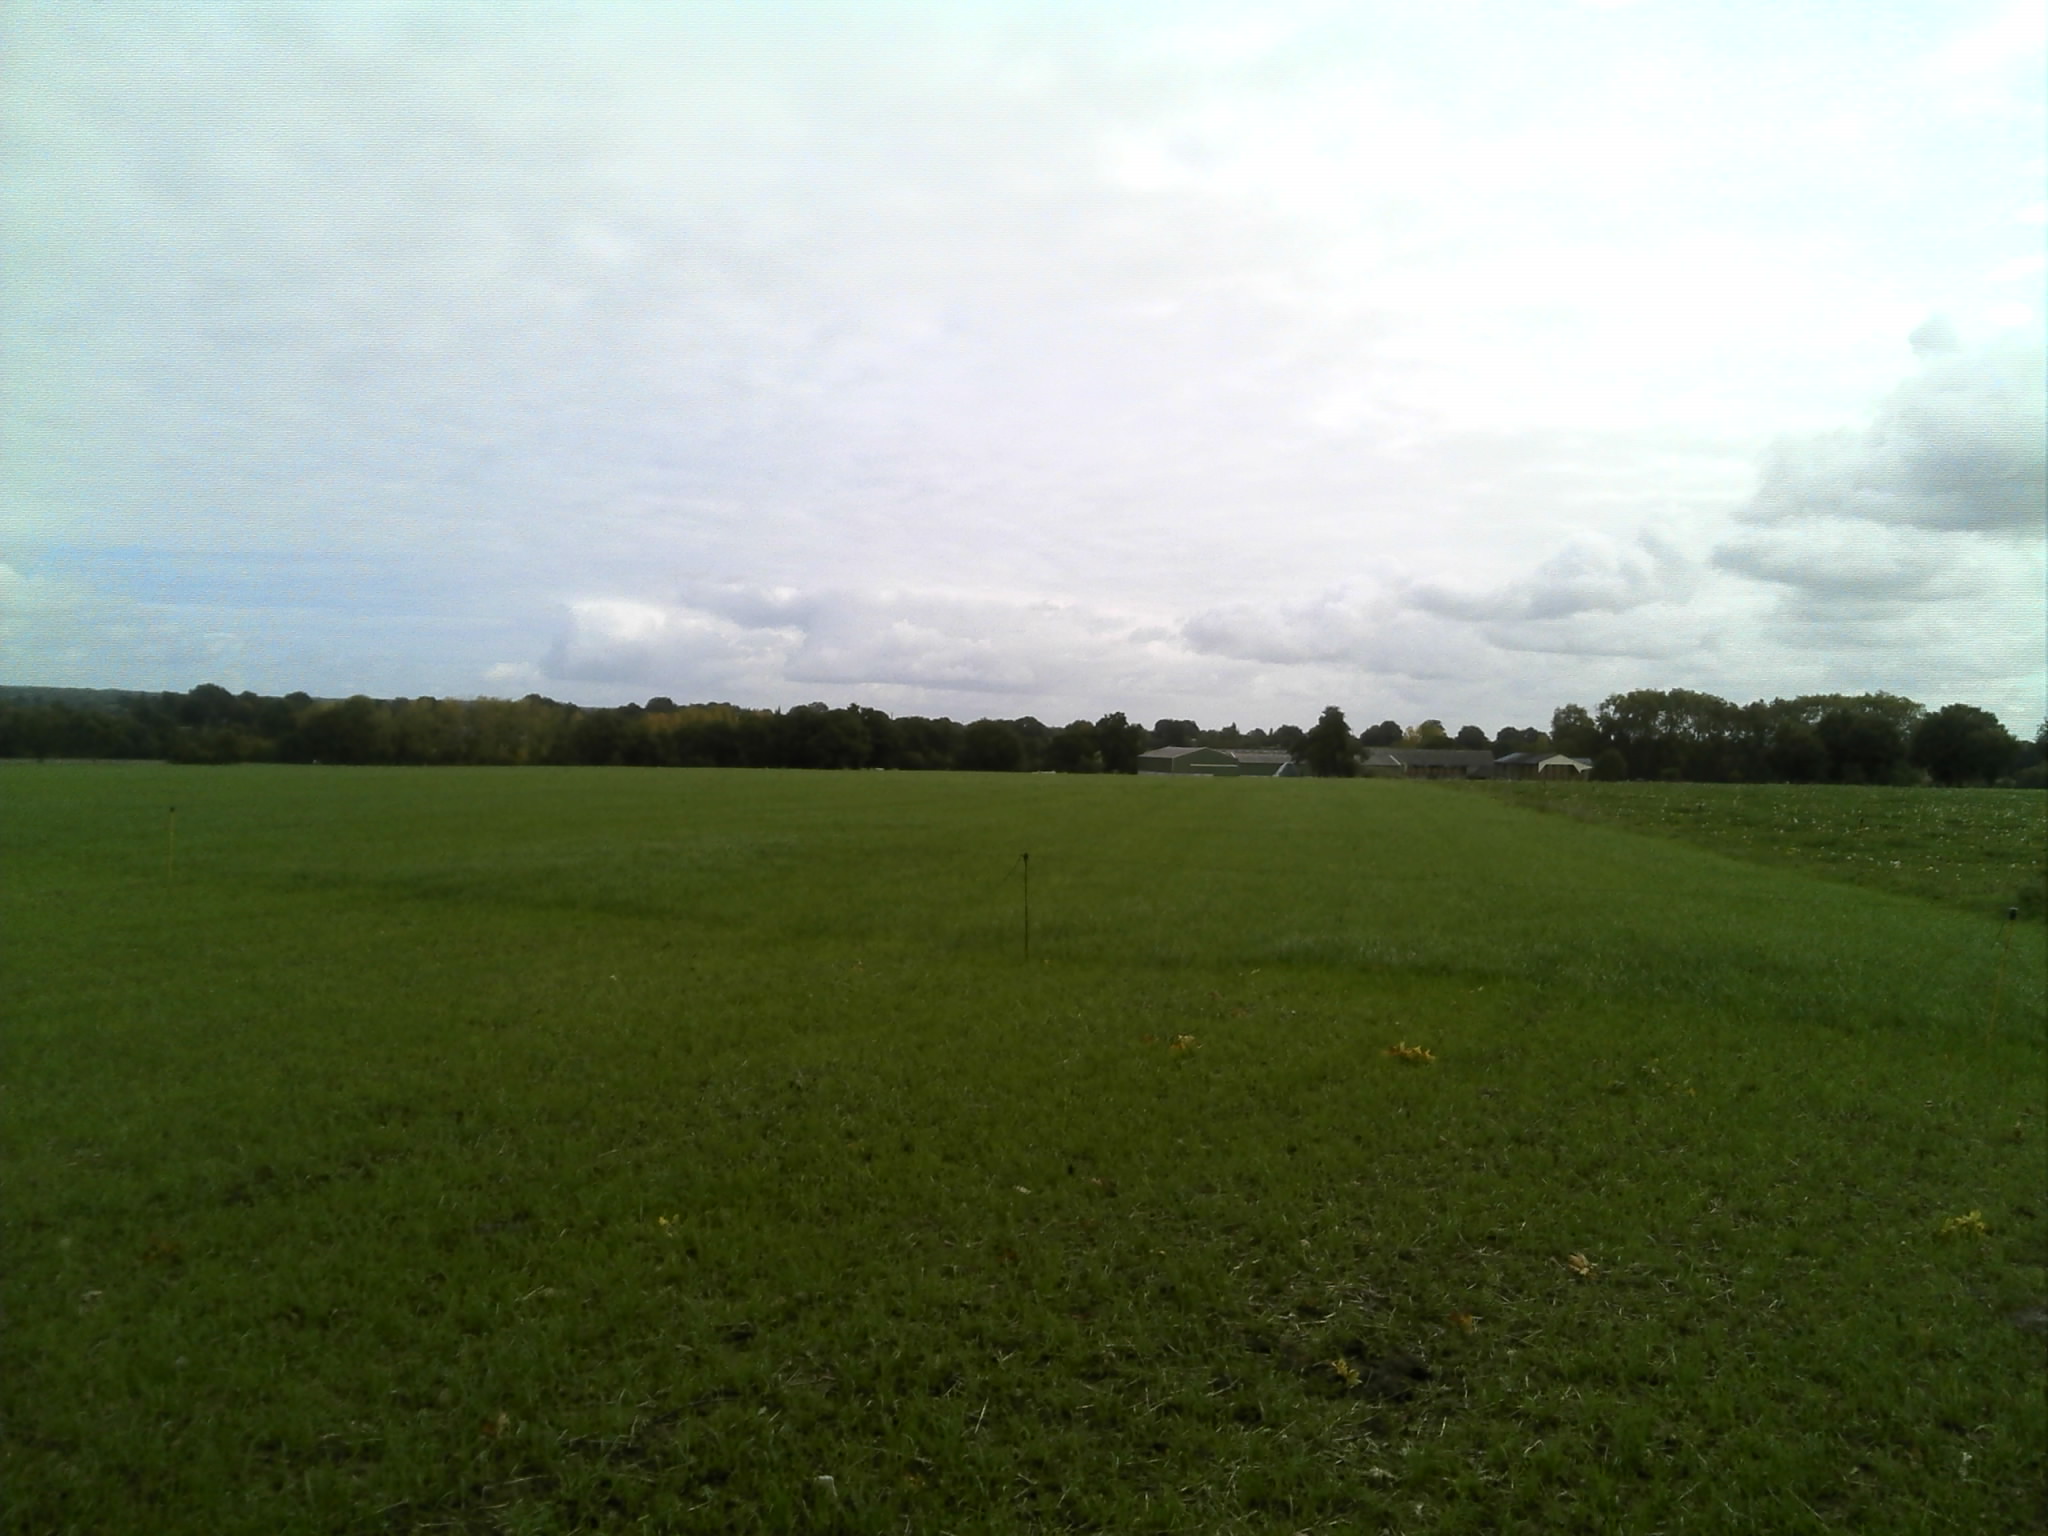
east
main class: Cropland
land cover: Temporary grasslands
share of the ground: > 75 %
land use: Agriculture (excluding fallow land and kitchen gardens)
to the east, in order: Temporary grasslands; Fences; Grassland without tree/shrub cover
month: October
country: FR
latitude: 47.6989
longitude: -1.0854
